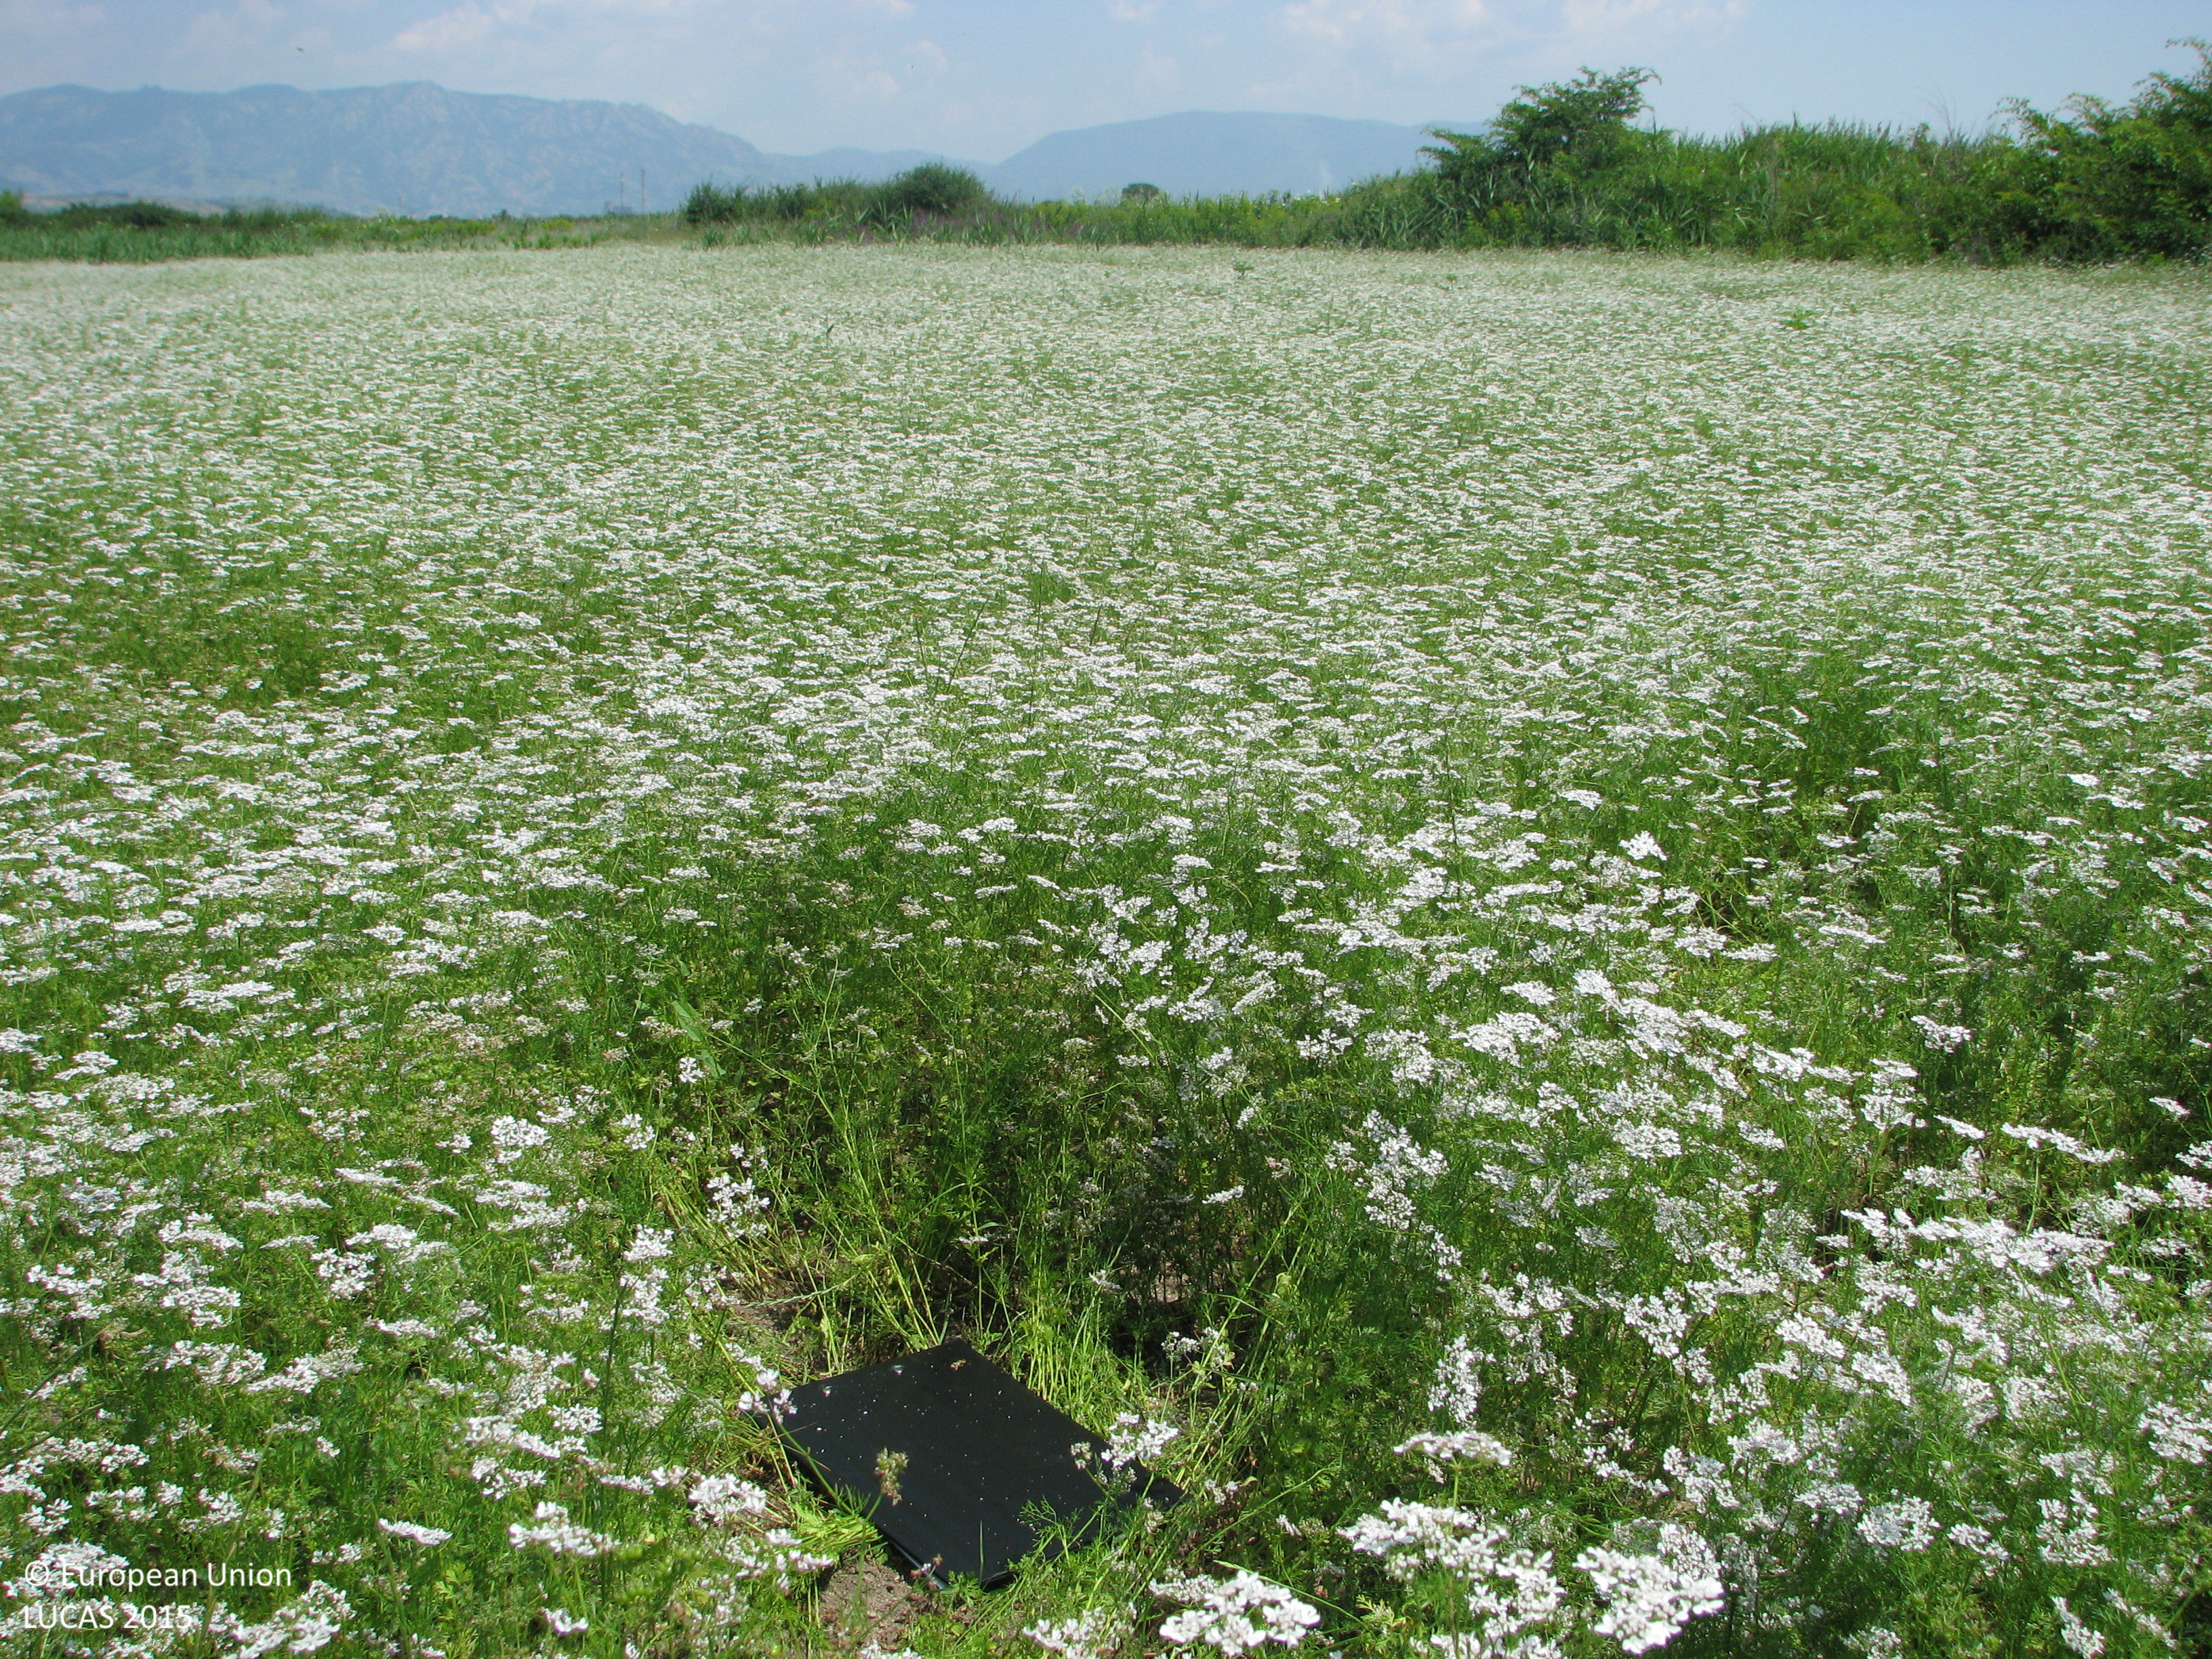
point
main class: Cropland
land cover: Other non-permanent industrial crops
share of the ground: > 75 %
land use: Agriculture (excluding fallow land and kitchen gardens)
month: June
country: BG
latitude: 42.6118
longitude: 26.2897
